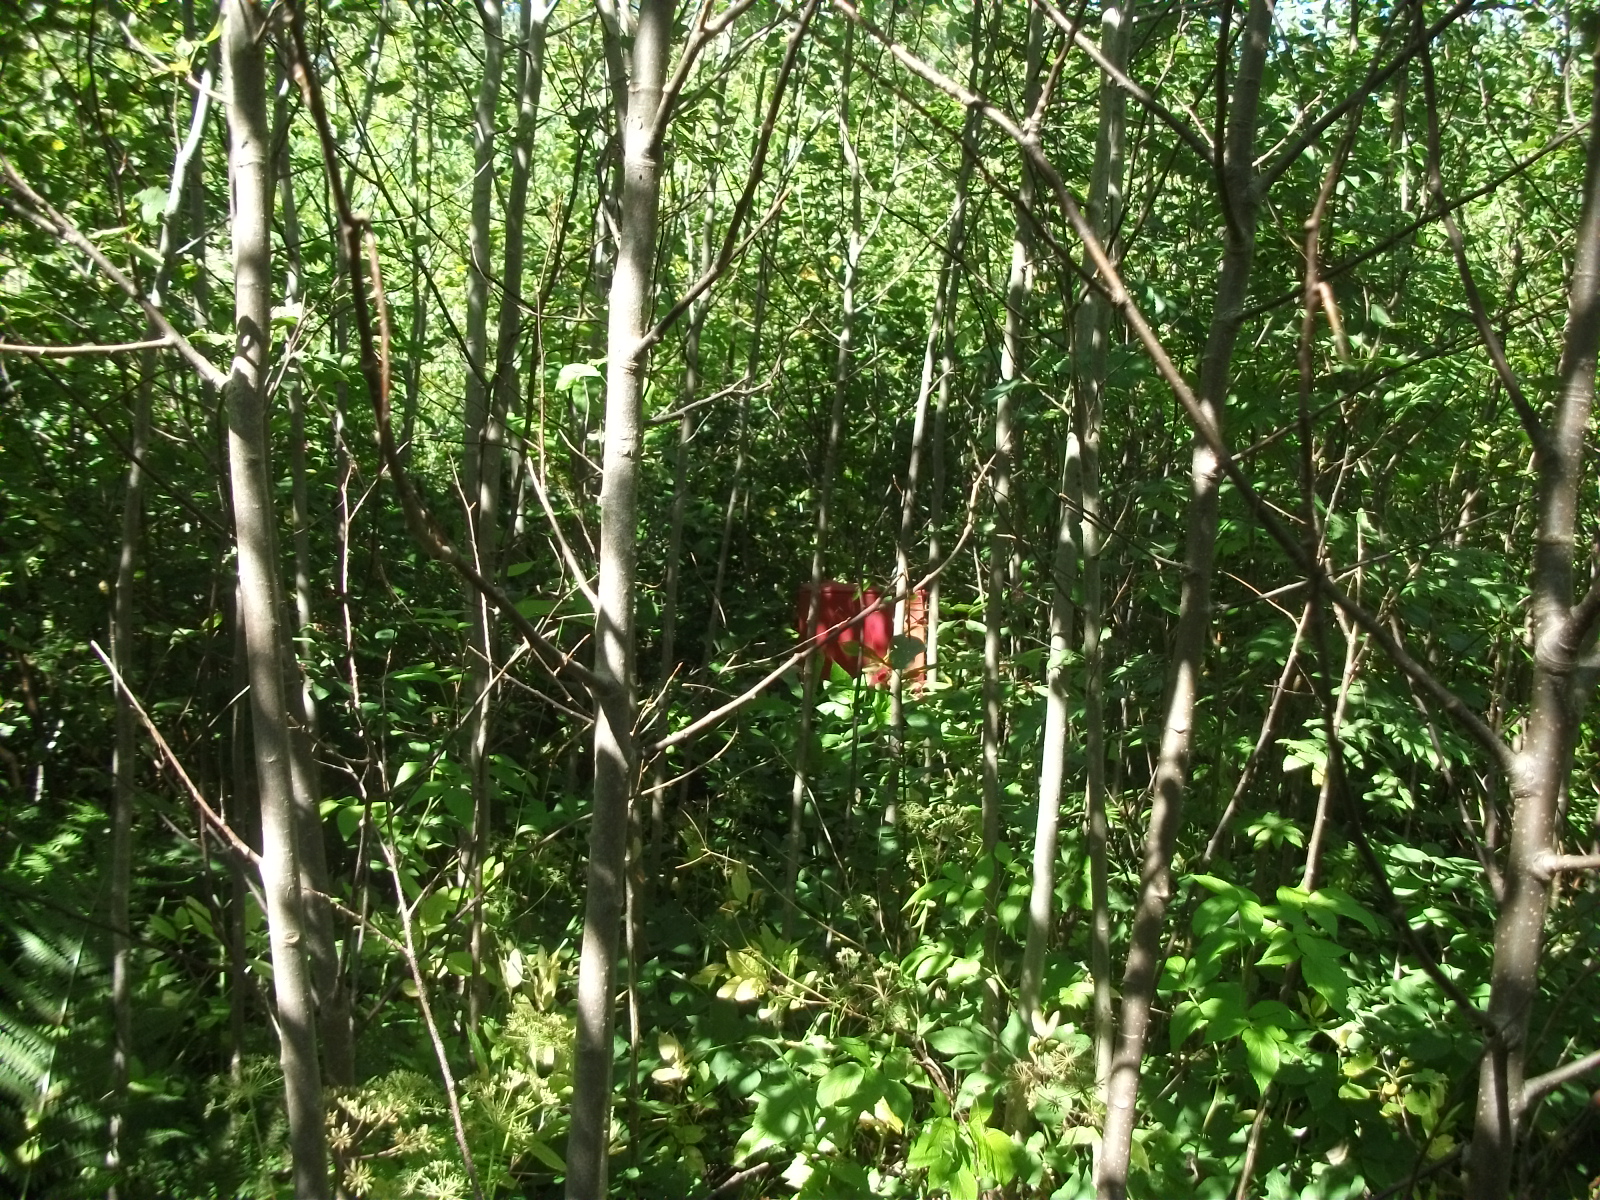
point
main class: Woodland
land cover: Broadleaved woodland
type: non-riverine alder, birch or aspen forest
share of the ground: > 75 %
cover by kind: broadleaved forest trees 95 %, shrubs 5 %
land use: Forestry
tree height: < 5 m
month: August
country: LV
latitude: 56.9917
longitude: 26.4550
